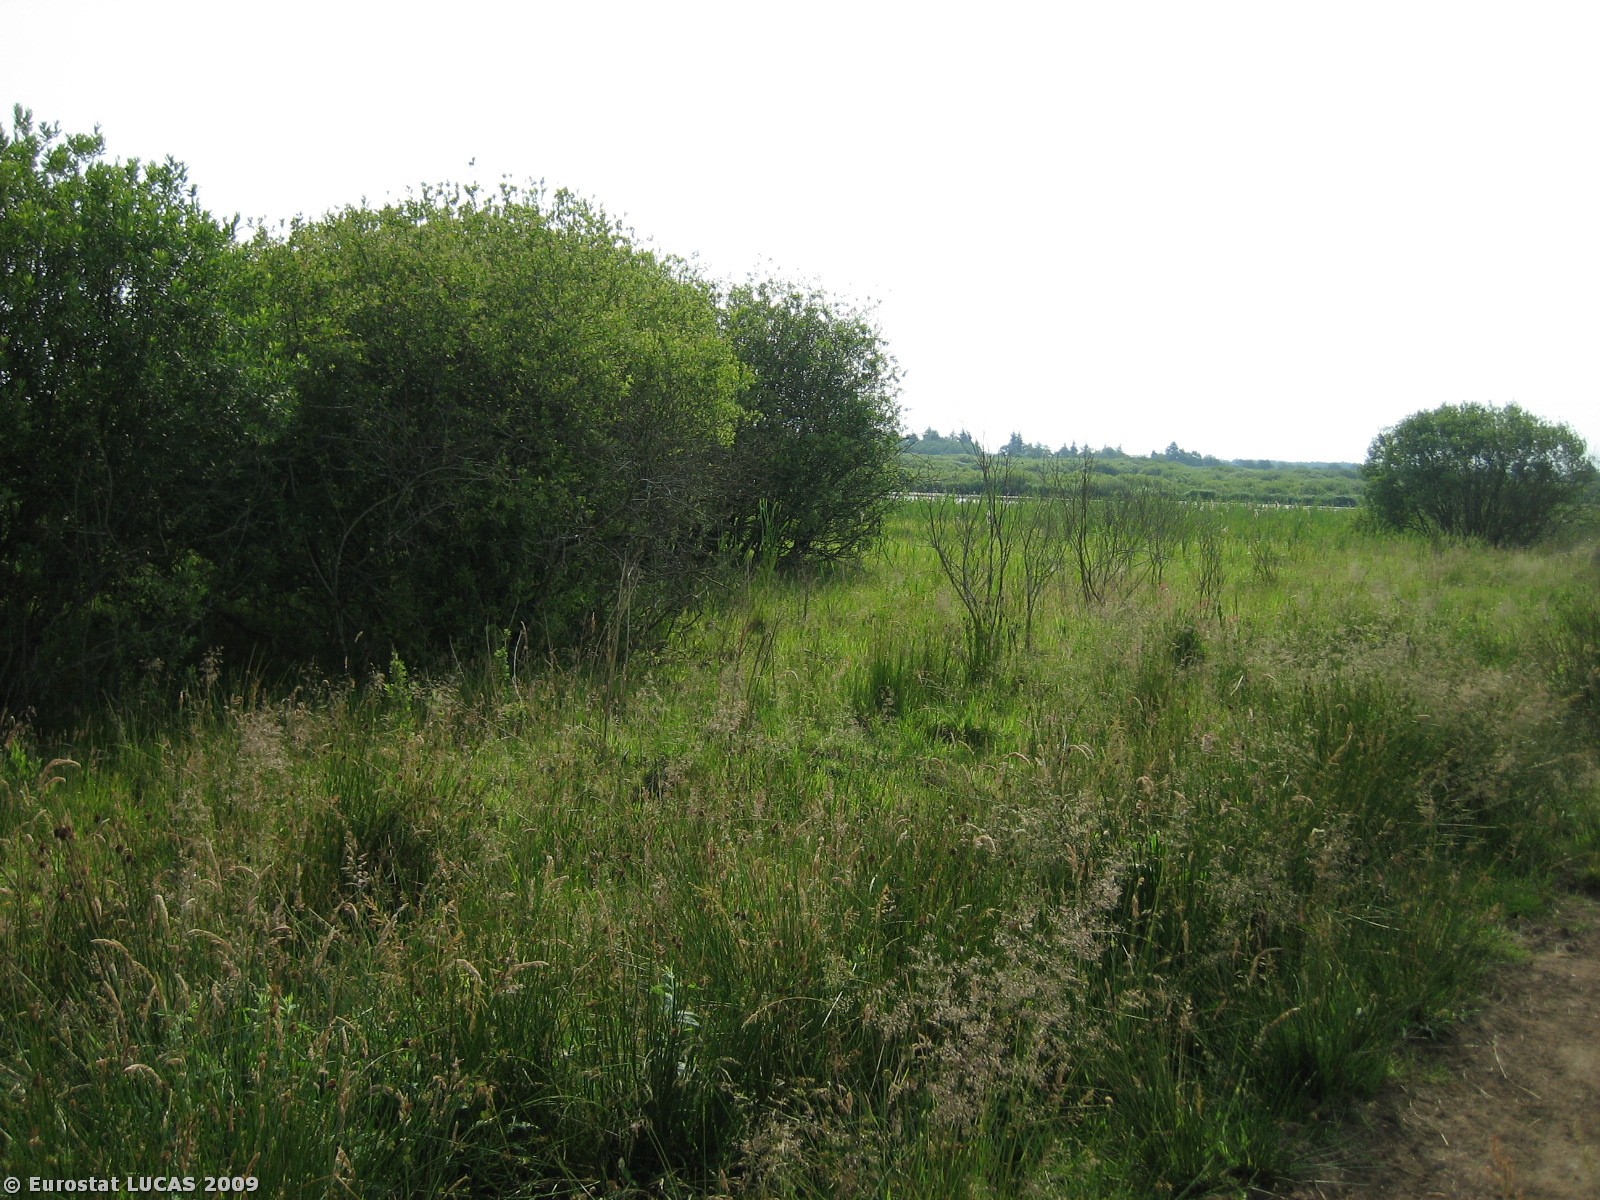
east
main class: Grassland
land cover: Grassland without tree/shrub cover
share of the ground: > 75 %
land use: Unused
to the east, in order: Grassland without tree/shrub cover; Ditches and canals; Grass margins; Fences; Grassland without tree/shrub cover; Inland marshes; Inland water bodies; Inland marshes; Inland water bodies; Inland marshes
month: July
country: DK
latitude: 55.3018
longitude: 8.8511
